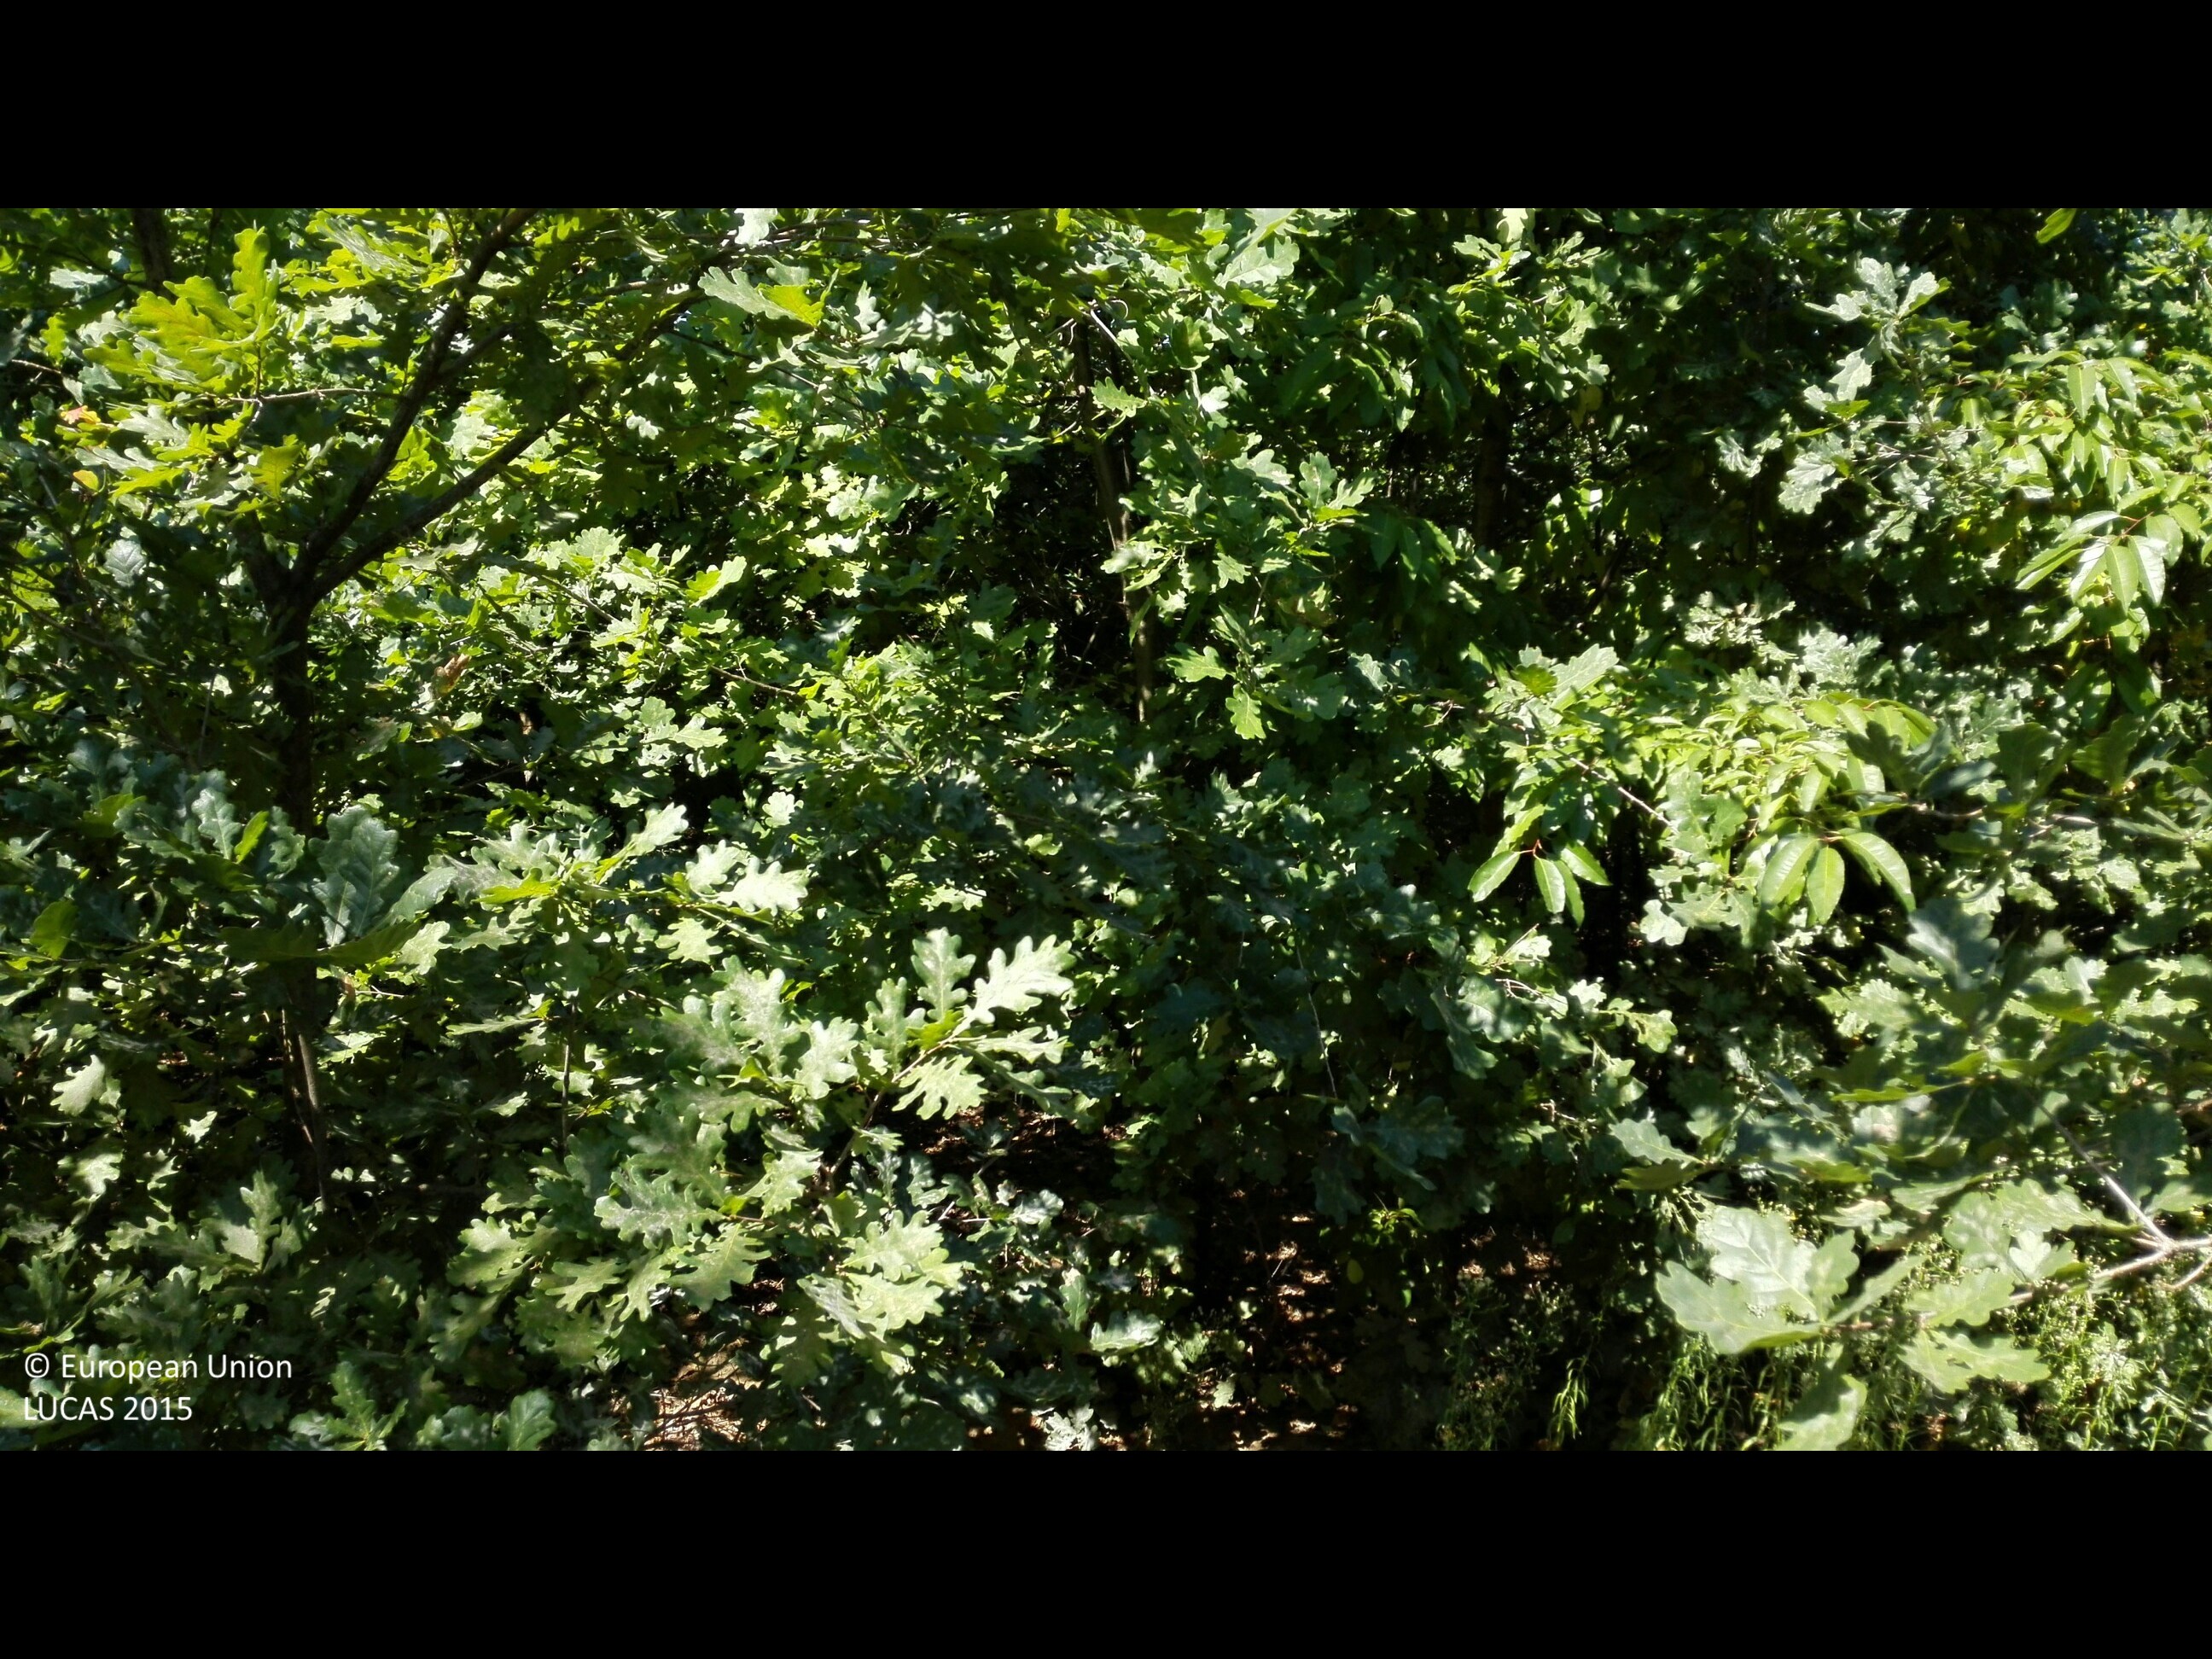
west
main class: Woodland
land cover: Broadleaved woodland
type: acidophilous oak and oak-birch forest
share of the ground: > 75 %
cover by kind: broadleaved forest trees 95 %, herbaceous plants 5 %
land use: Forestry
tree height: < 5 m
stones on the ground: < 10 %
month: August
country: HU
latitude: 47.4615
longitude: 21.7864
